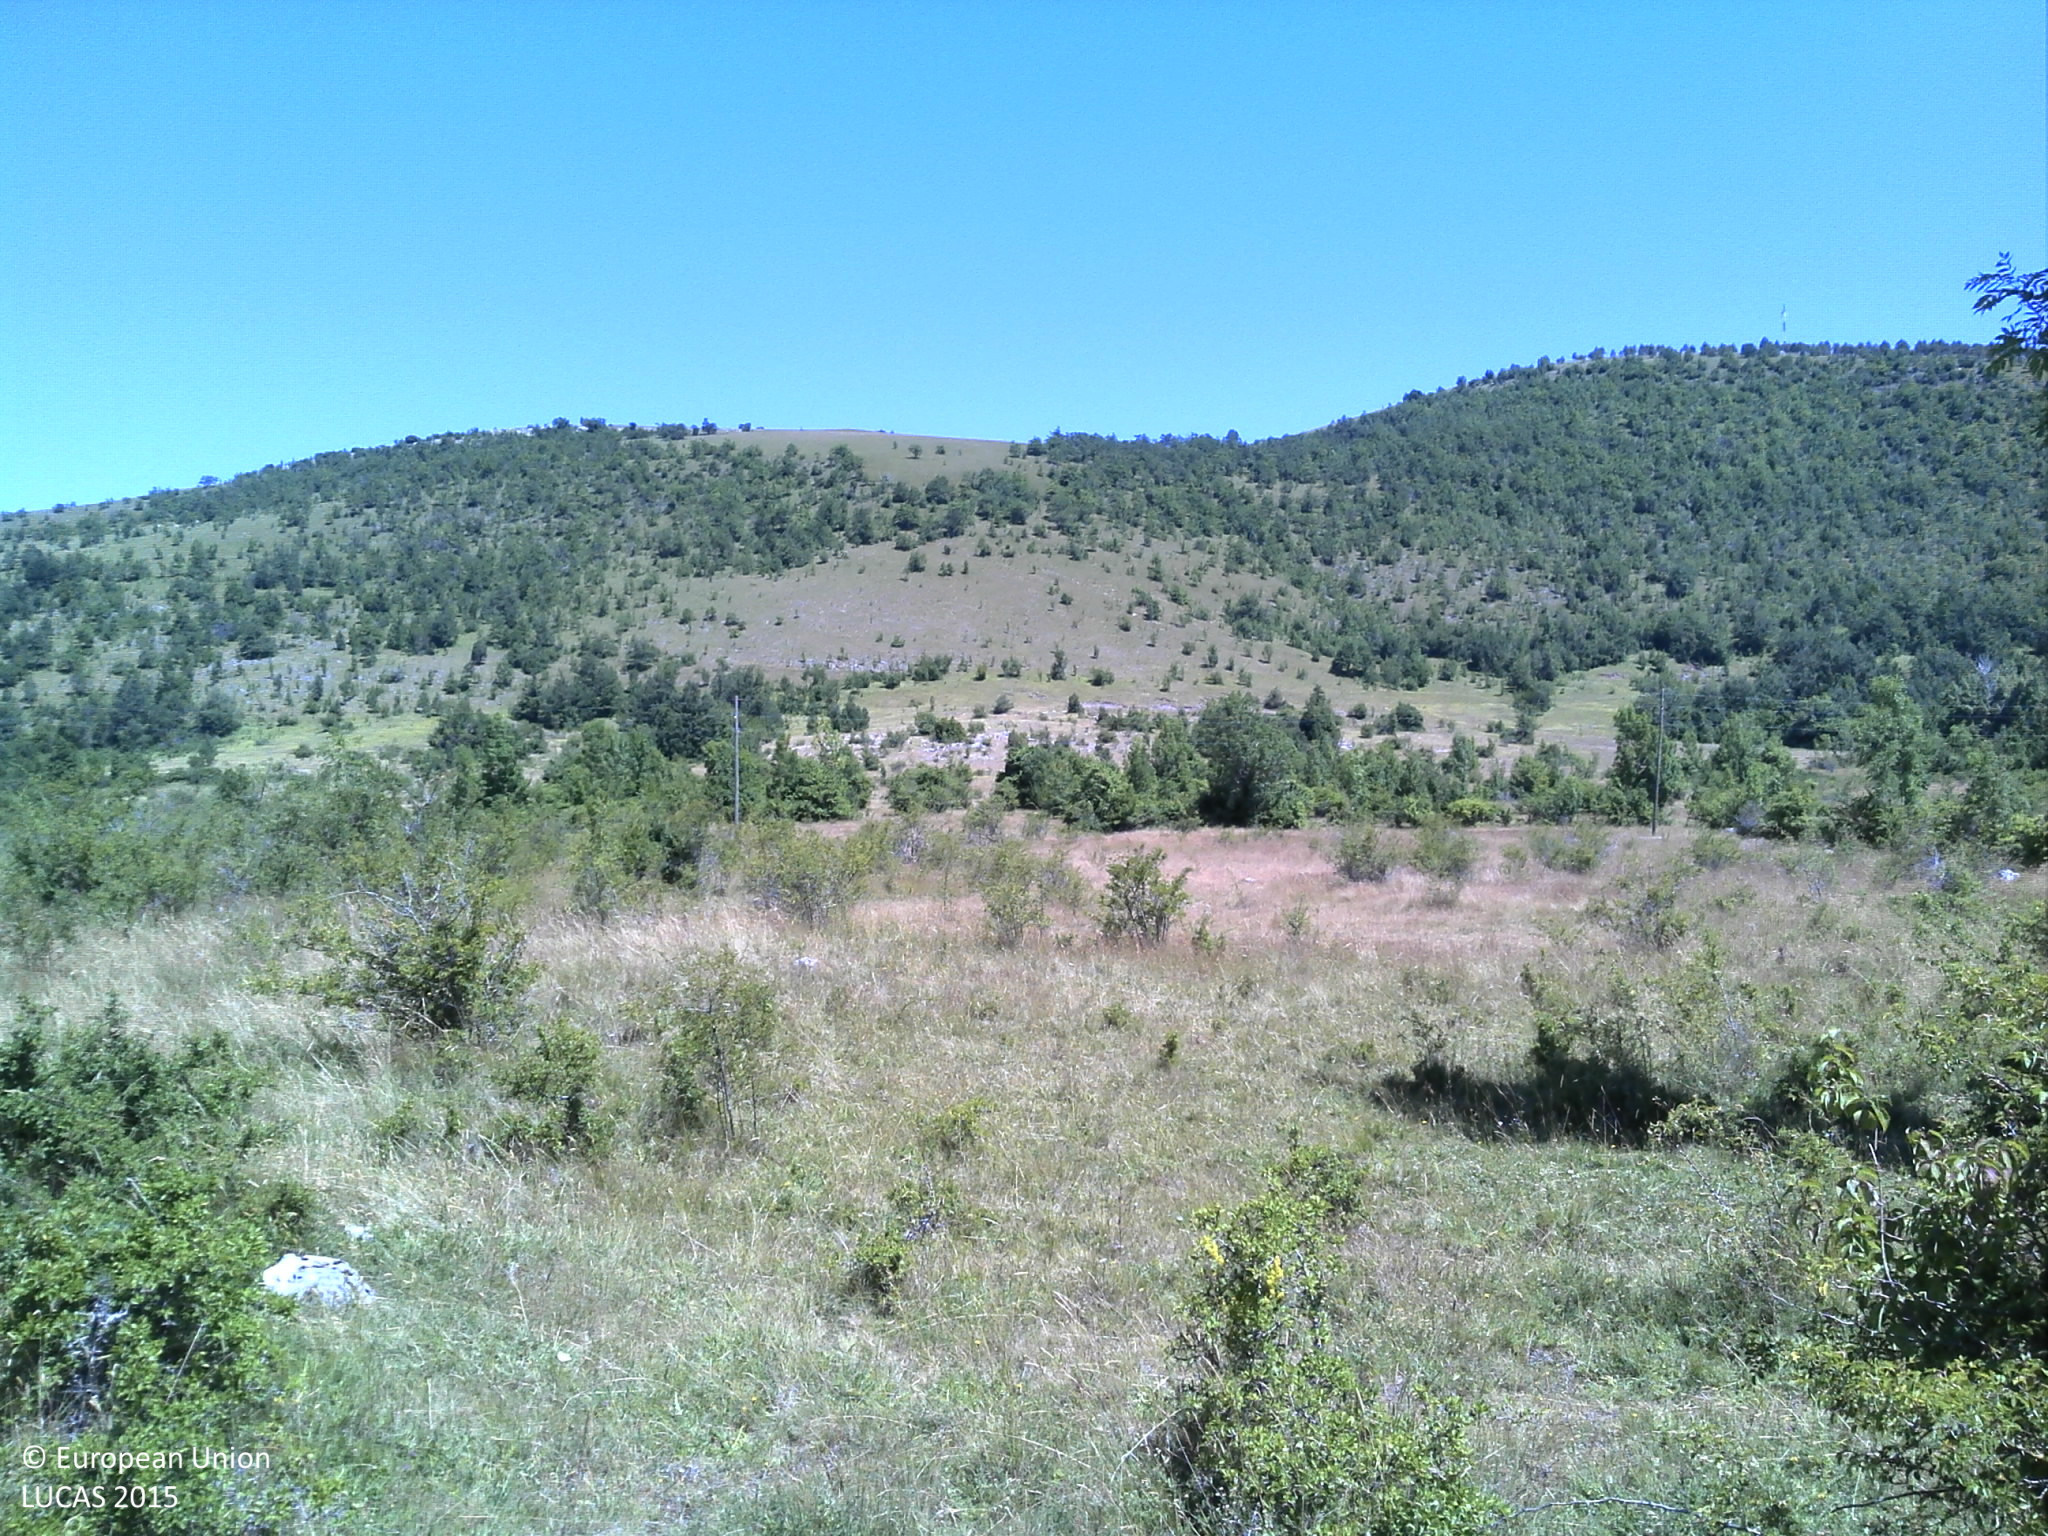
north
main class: Shrubland
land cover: Shrubland with sparse tree cover
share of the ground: 25 - 50 %
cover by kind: herbaceous plants 55 %, shrubs 40 %, broadleaved forest trees 5 %
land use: Semi-natural and natural areas not in use
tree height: < 5 m
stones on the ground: < 10 %
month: July
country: HR
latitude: 44.4006
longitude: 15.8820
